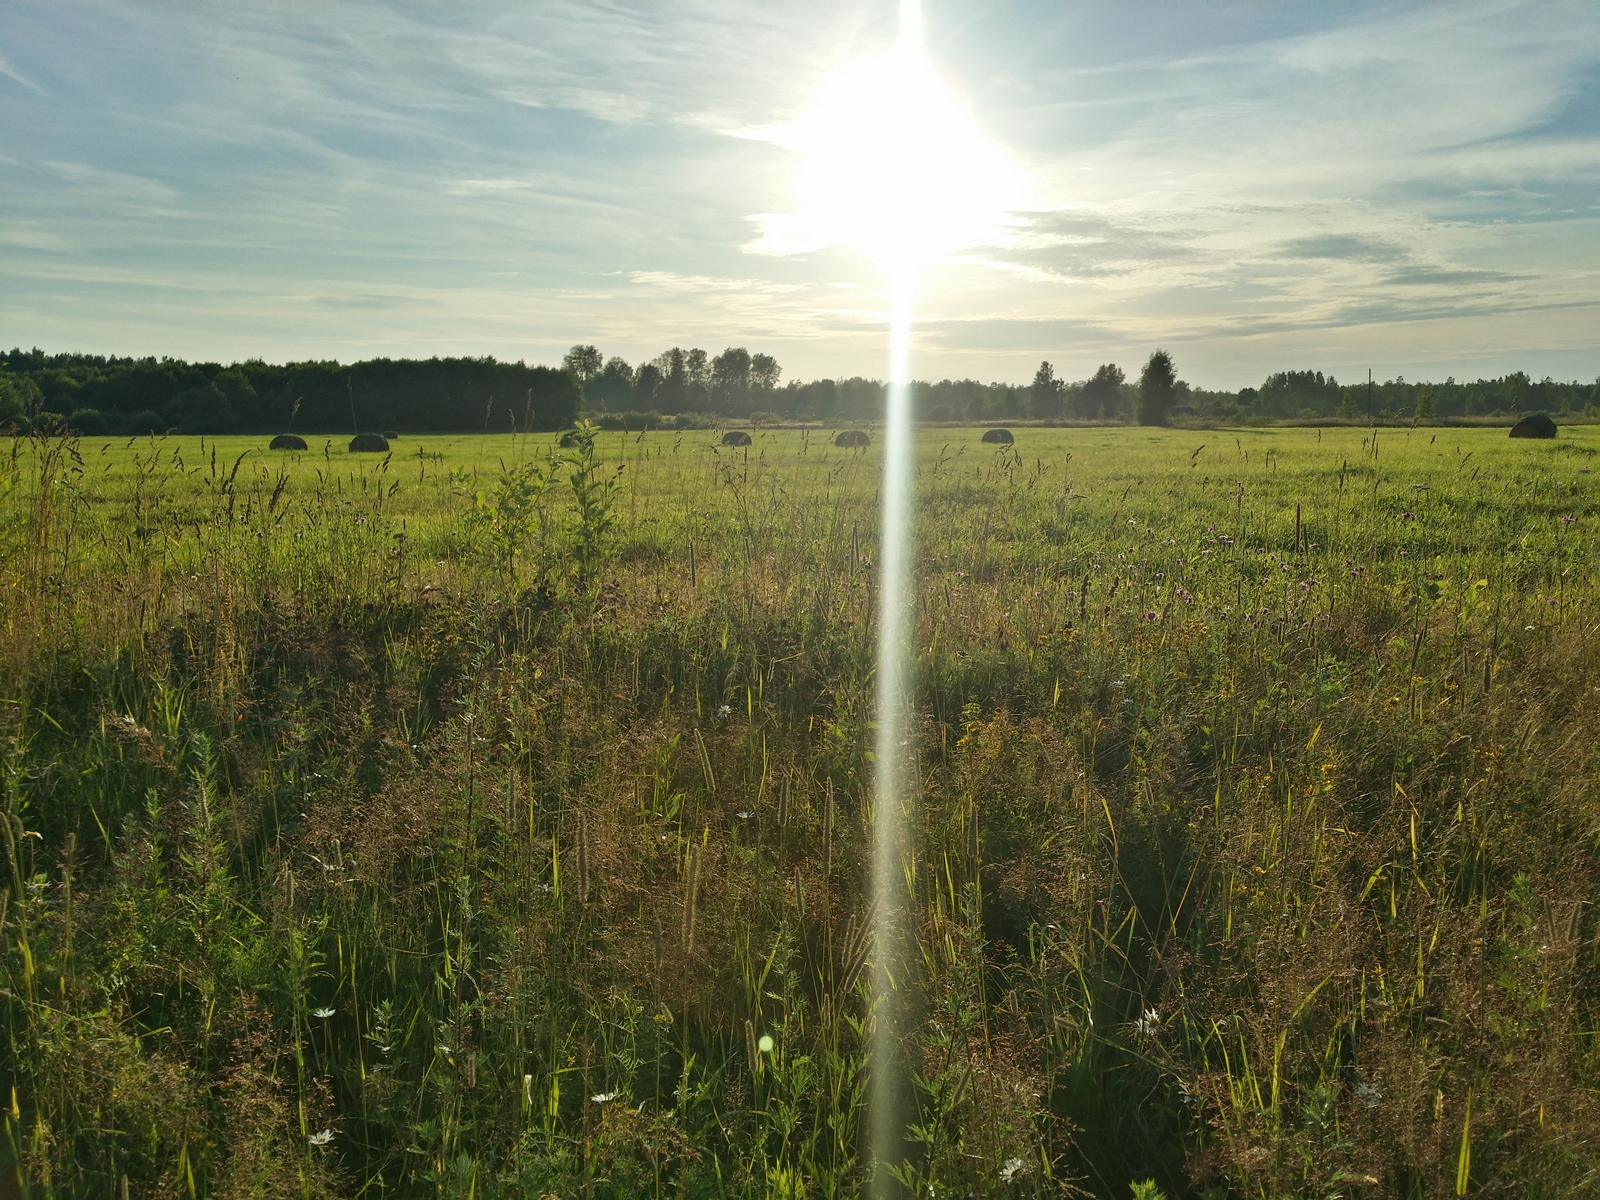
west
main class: Grassland
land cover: Spontaneously vegetated surfaces
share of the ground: > 75 %
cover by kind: herbaceous plants 100 %
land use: Semi-natural and natural areas not in use
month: July
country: LV
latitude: 57.1124
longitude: 27.2245
